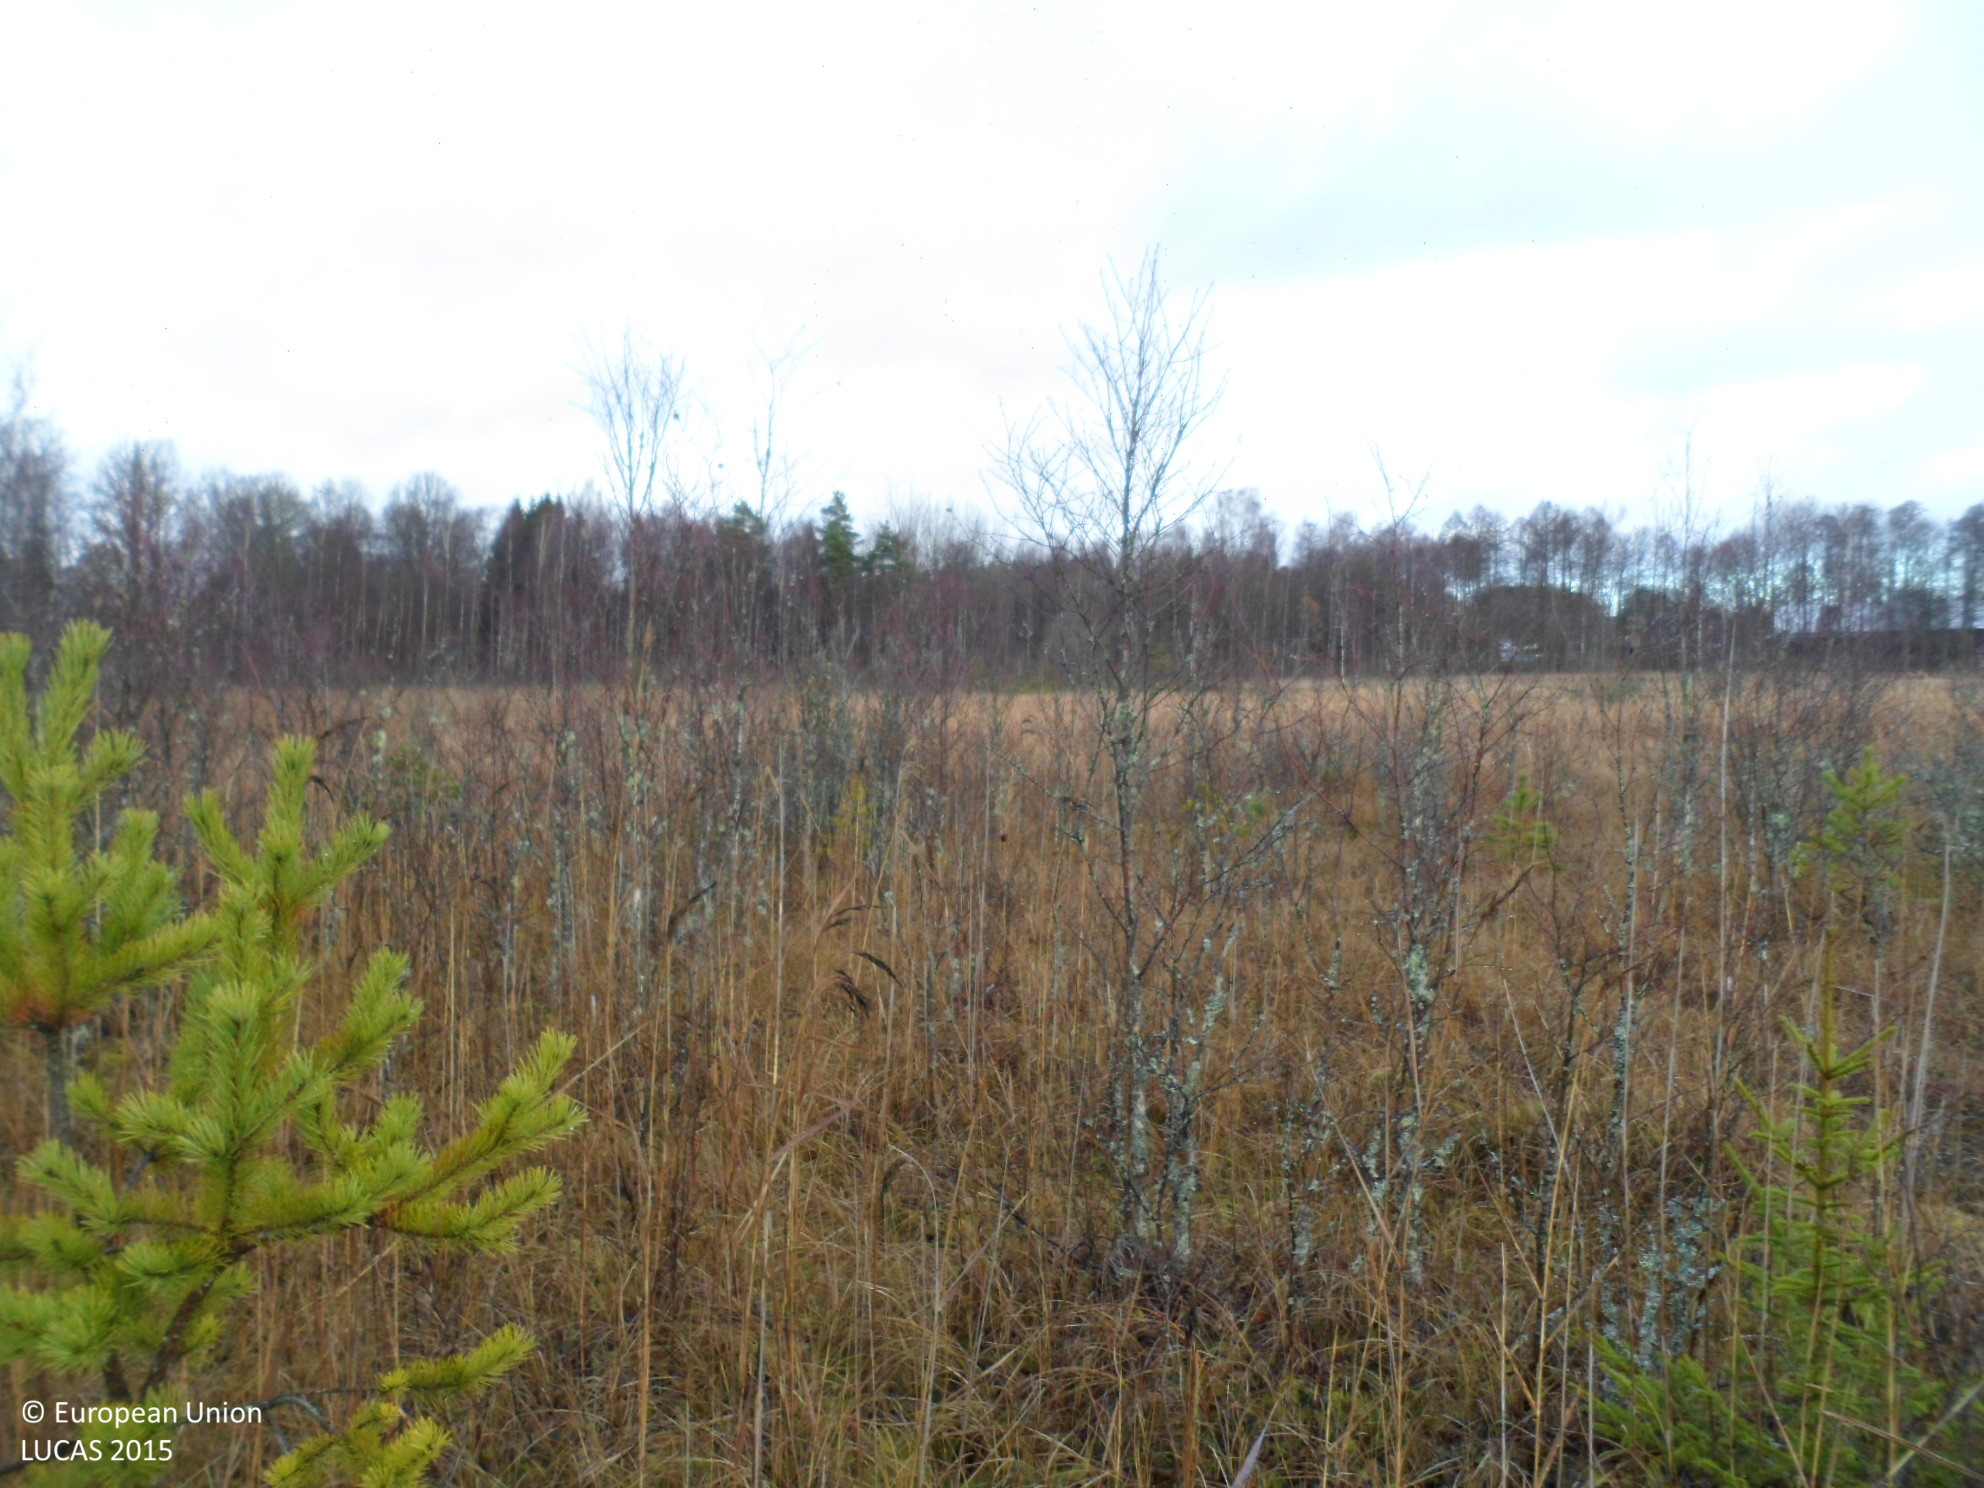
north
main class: Woodland
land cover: Pine dominated mixed woodland
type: mire and swamp forests
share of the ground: 10 - 25 %
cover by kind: lichens and mosses 40 %, herbaceous plants 30 %, coniferous forest trees 10 %, broadleaved forest trees 10 %, shrubs 10 %
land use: Semi-natural and natural areas not in use
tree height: < 5 m
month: November
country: SE
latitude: 57.5625
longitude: 15.9986
